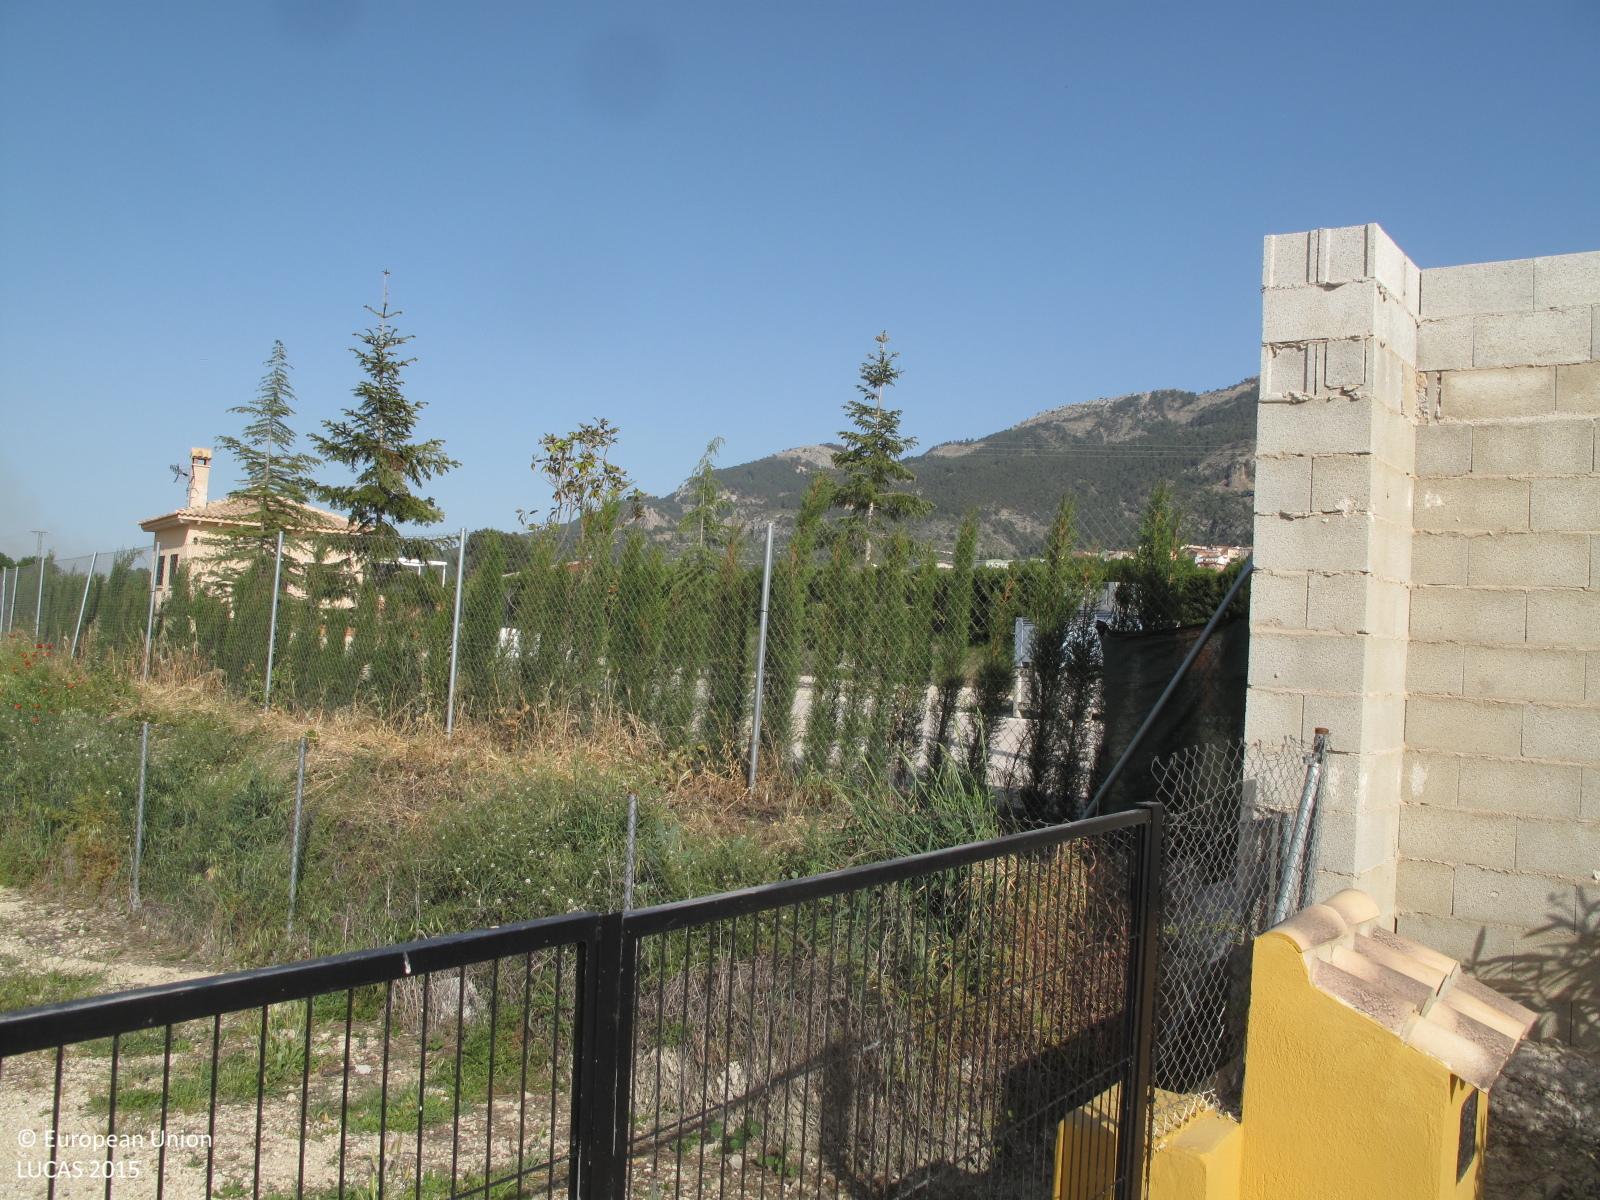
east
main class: Grassland
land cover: Grassland with sparse tree/shrub cover
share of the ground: > 75 %
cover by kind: herbaceous plants 95 %, broadleaved forest trees 5 %
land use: Residential
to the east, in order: Grassland with sparse tree/shrub cover; Tracks; Grassland with sparse tree/shrub cover; Fences; Electric lines; Grass margins; Fences; Other fruit trees and berries; Fences; Other bare soil
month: May
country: ES
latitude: 38.7875
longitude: -0.5243
